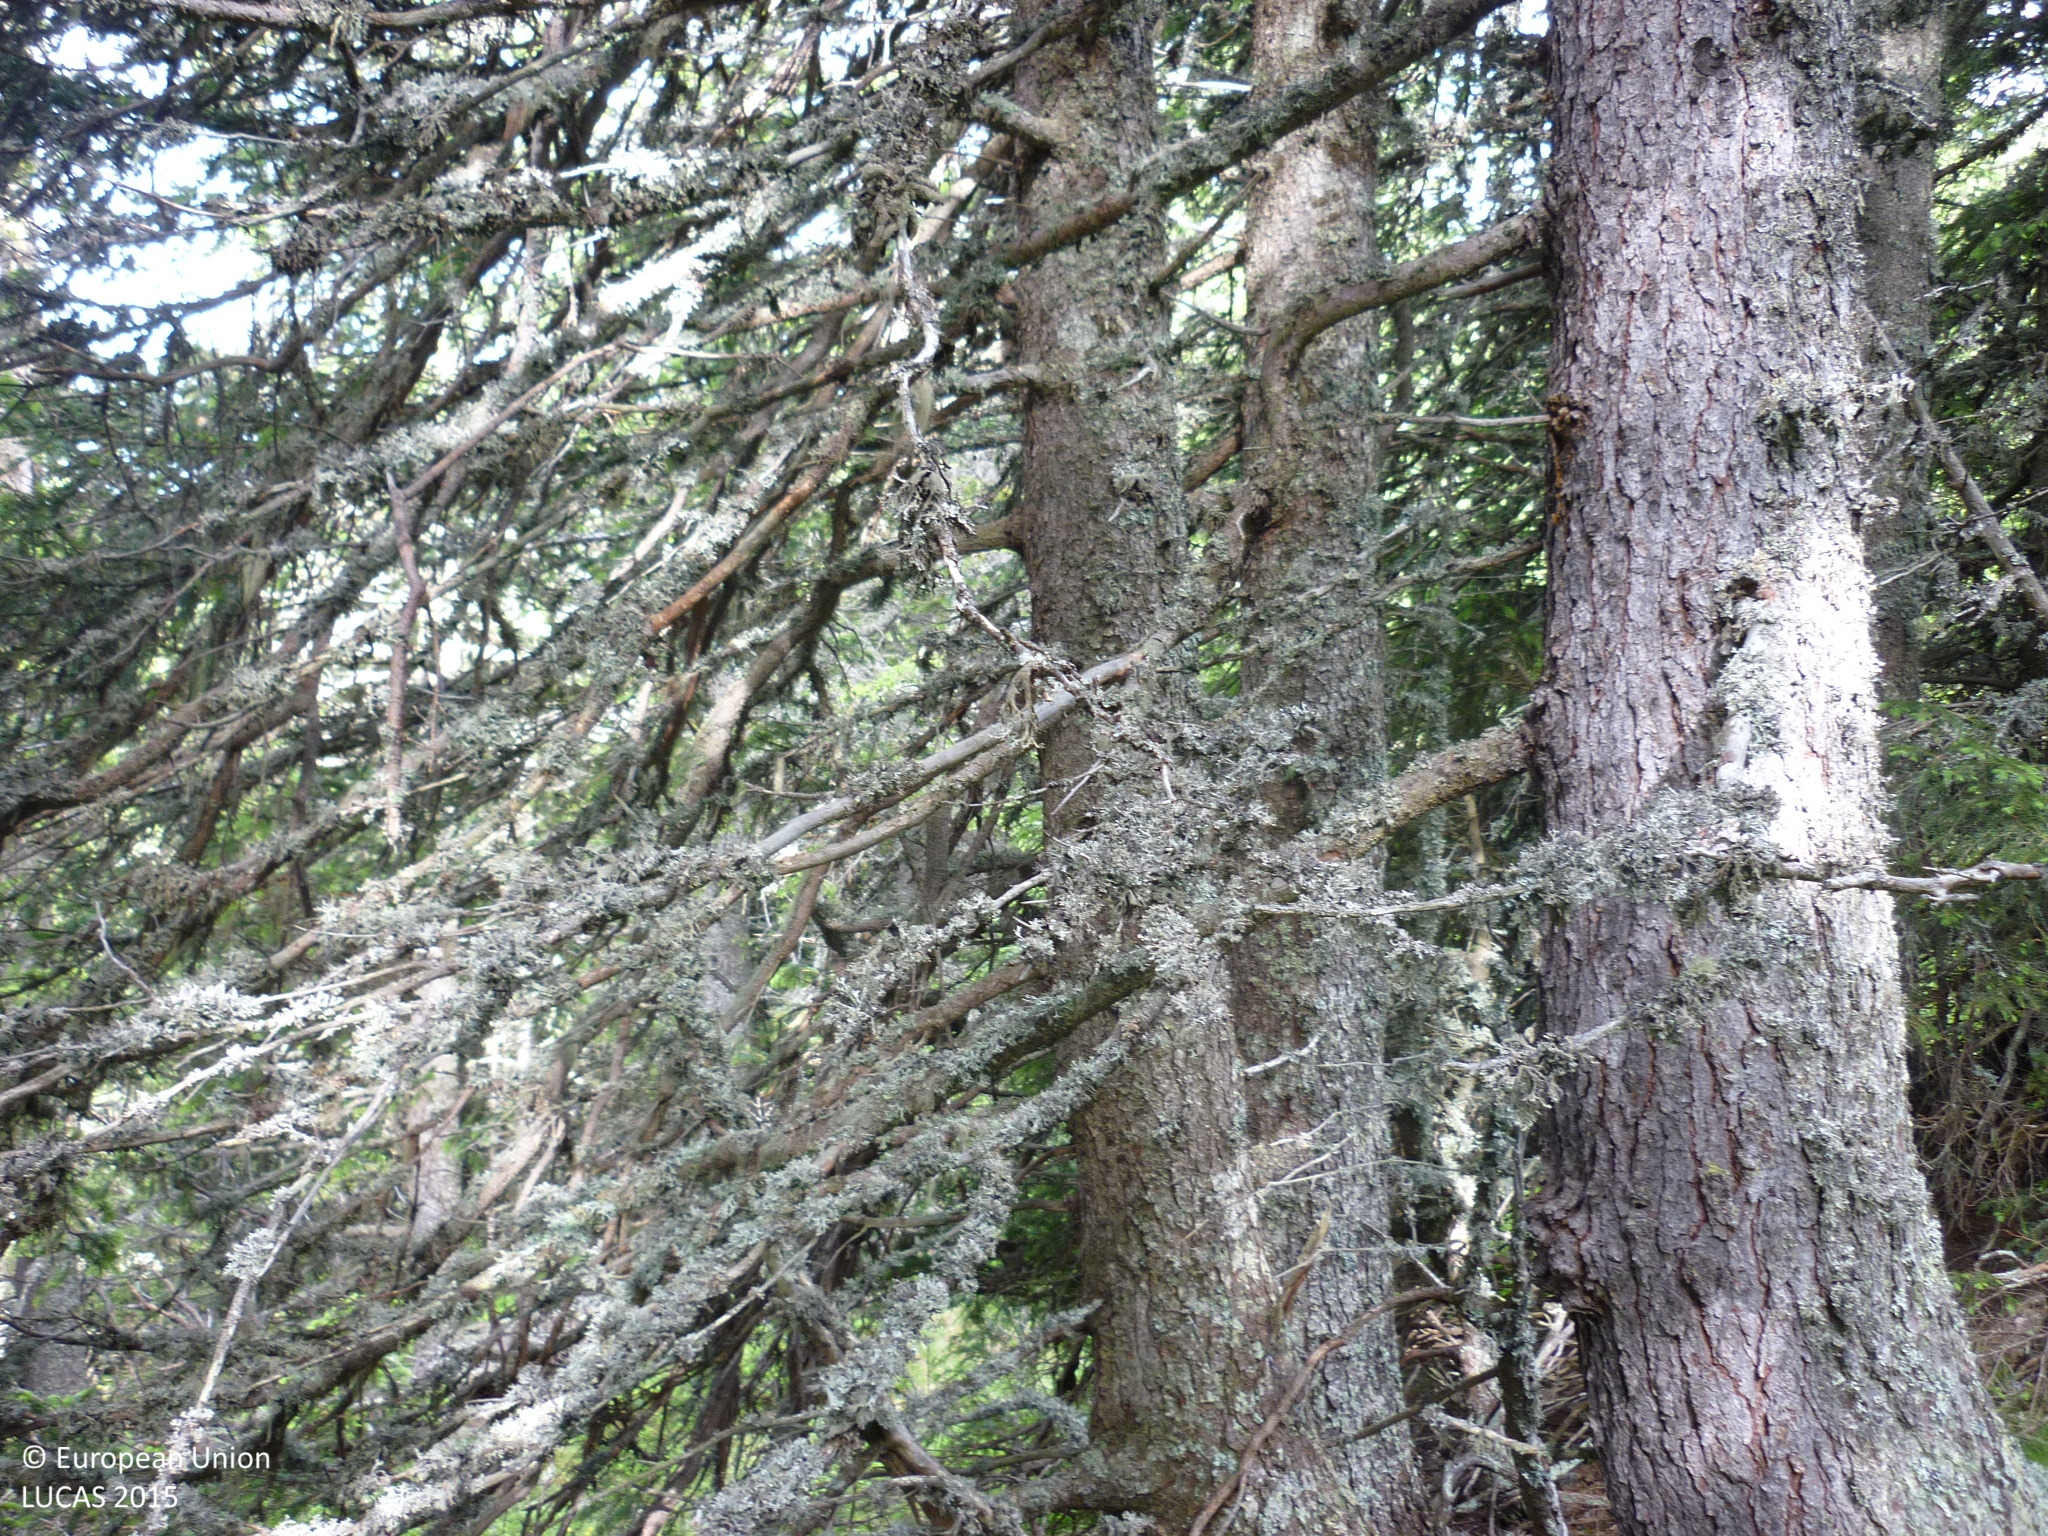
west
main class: Woodland
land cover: Spruce dominated coniferous woodland
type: alpine coniferous forest
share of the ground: 50 - 75 %
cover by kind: coniferous forest trees 60 %, herbaceous plants 20 %, shrubs 15 %, lichens and mosses 5 %
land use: Agriculture (excluding fallow land and kitchen gardens)
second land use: Forestry
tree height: > 5 m
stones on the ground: < 10 %
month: June
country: AT
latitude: 47.2260
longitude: 14.1585
